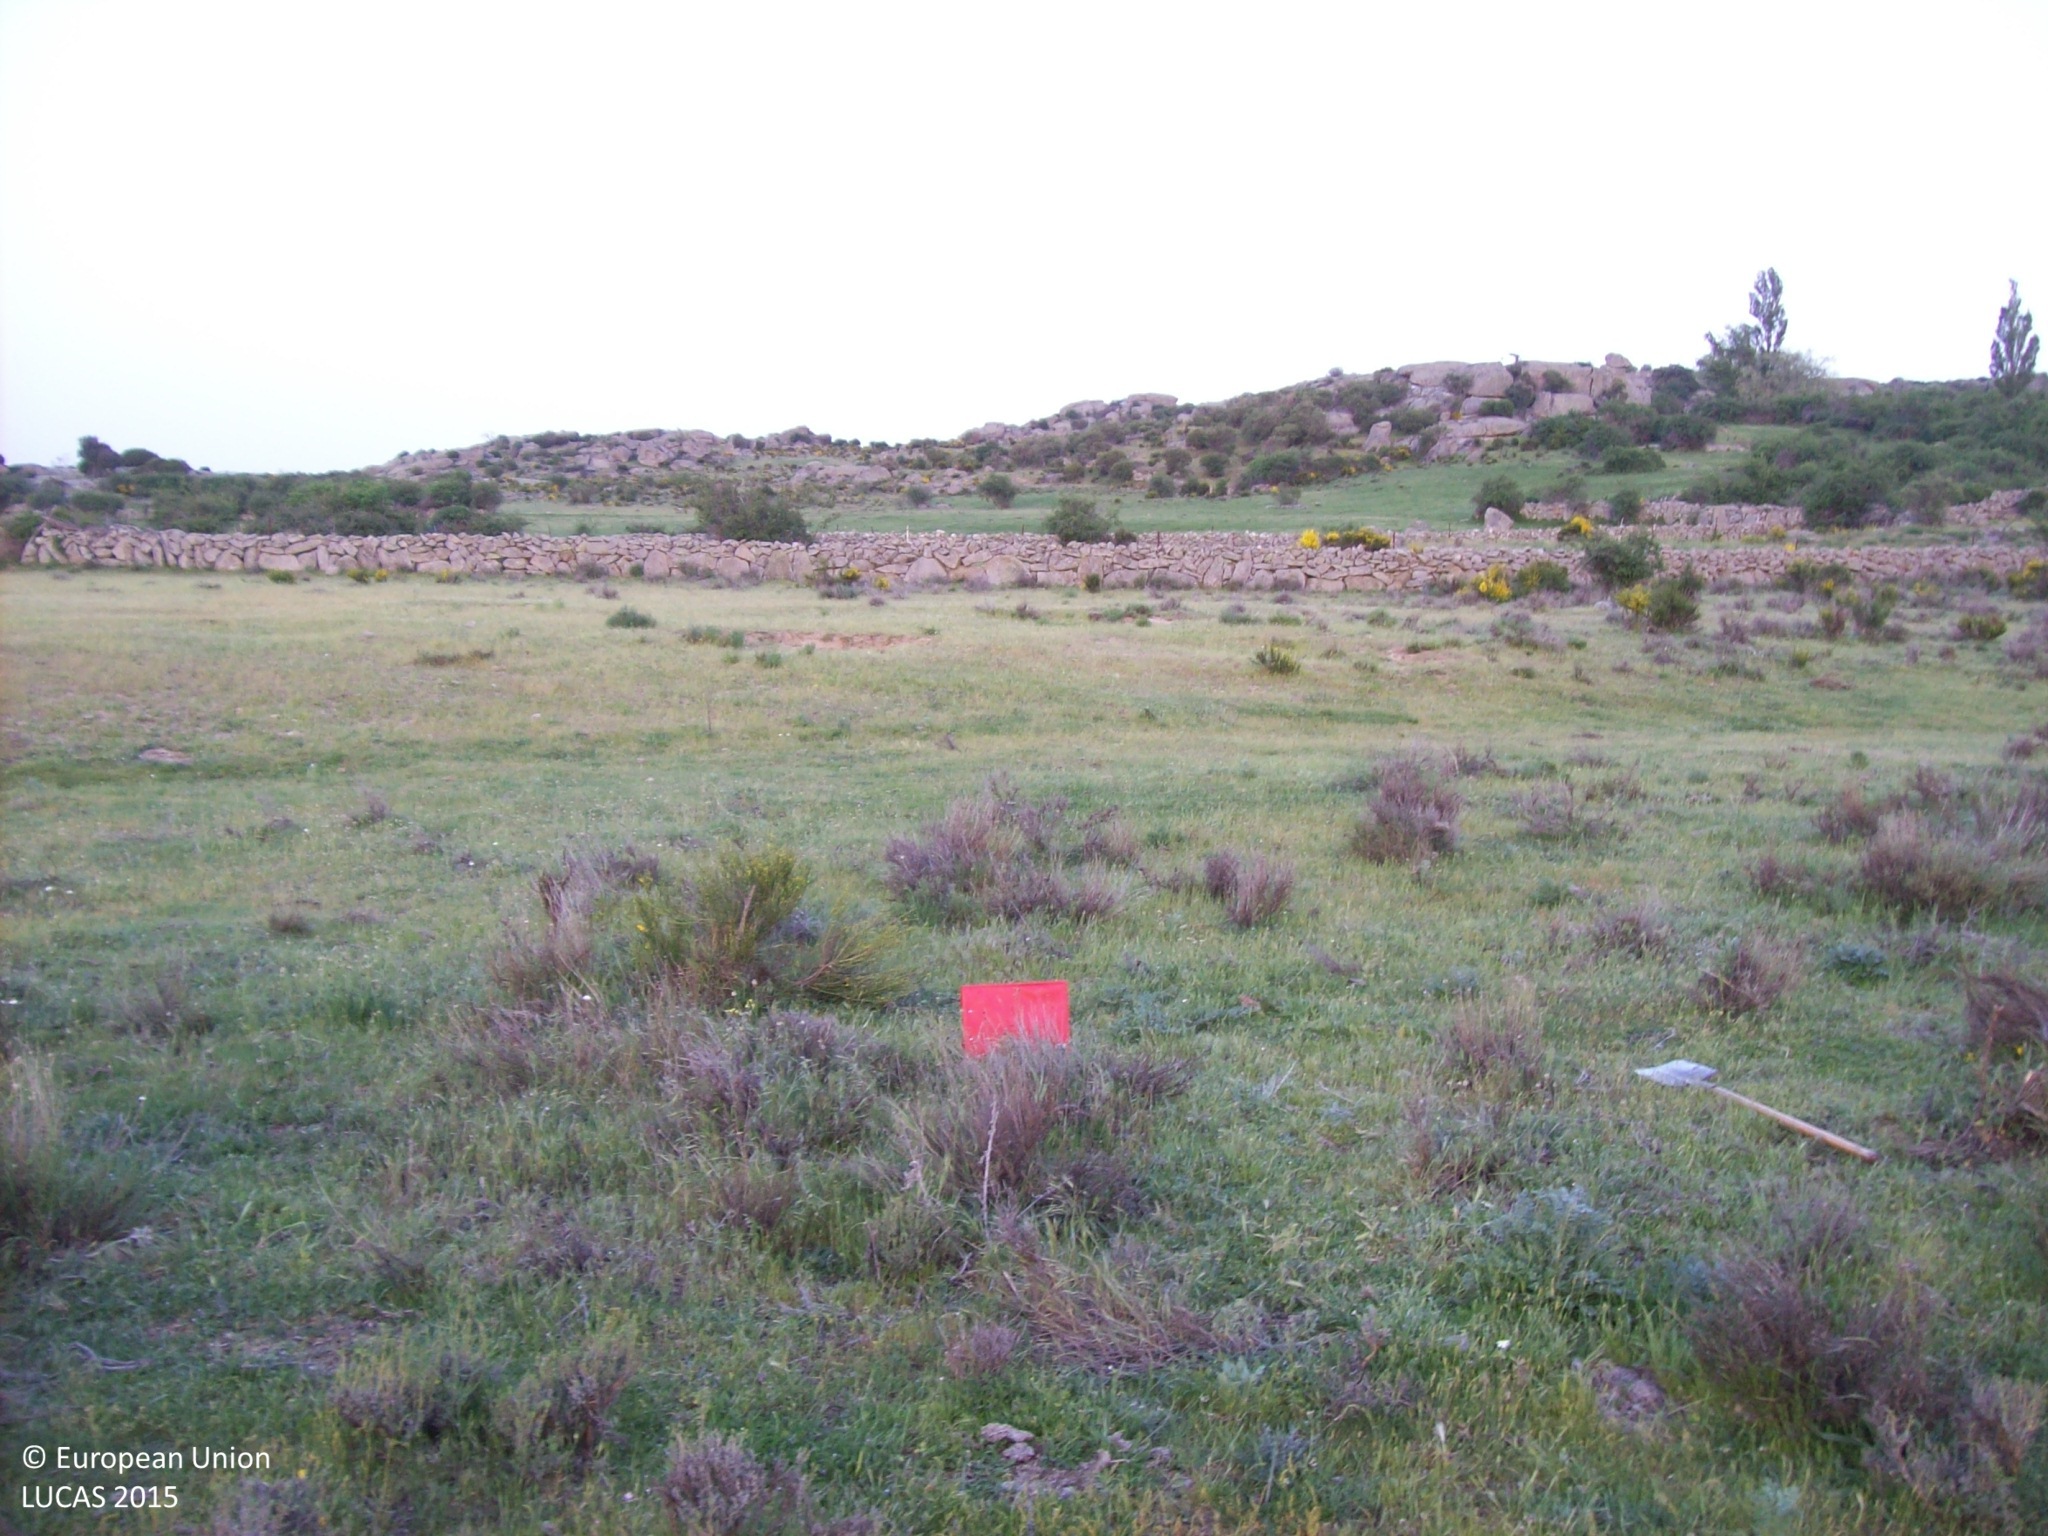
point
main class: Shrubland
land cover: Shrubland without tree cover
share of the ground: 25 - 50 %
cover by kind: herbaceous plants 65 %, shrubs 30 %, consolidated bare surface 5 %
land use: Agriculture (excluding fallow land and kitchen gardens)
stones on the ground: < 10 %
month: May
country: ES
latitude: 40.6921
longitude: -4.9589
